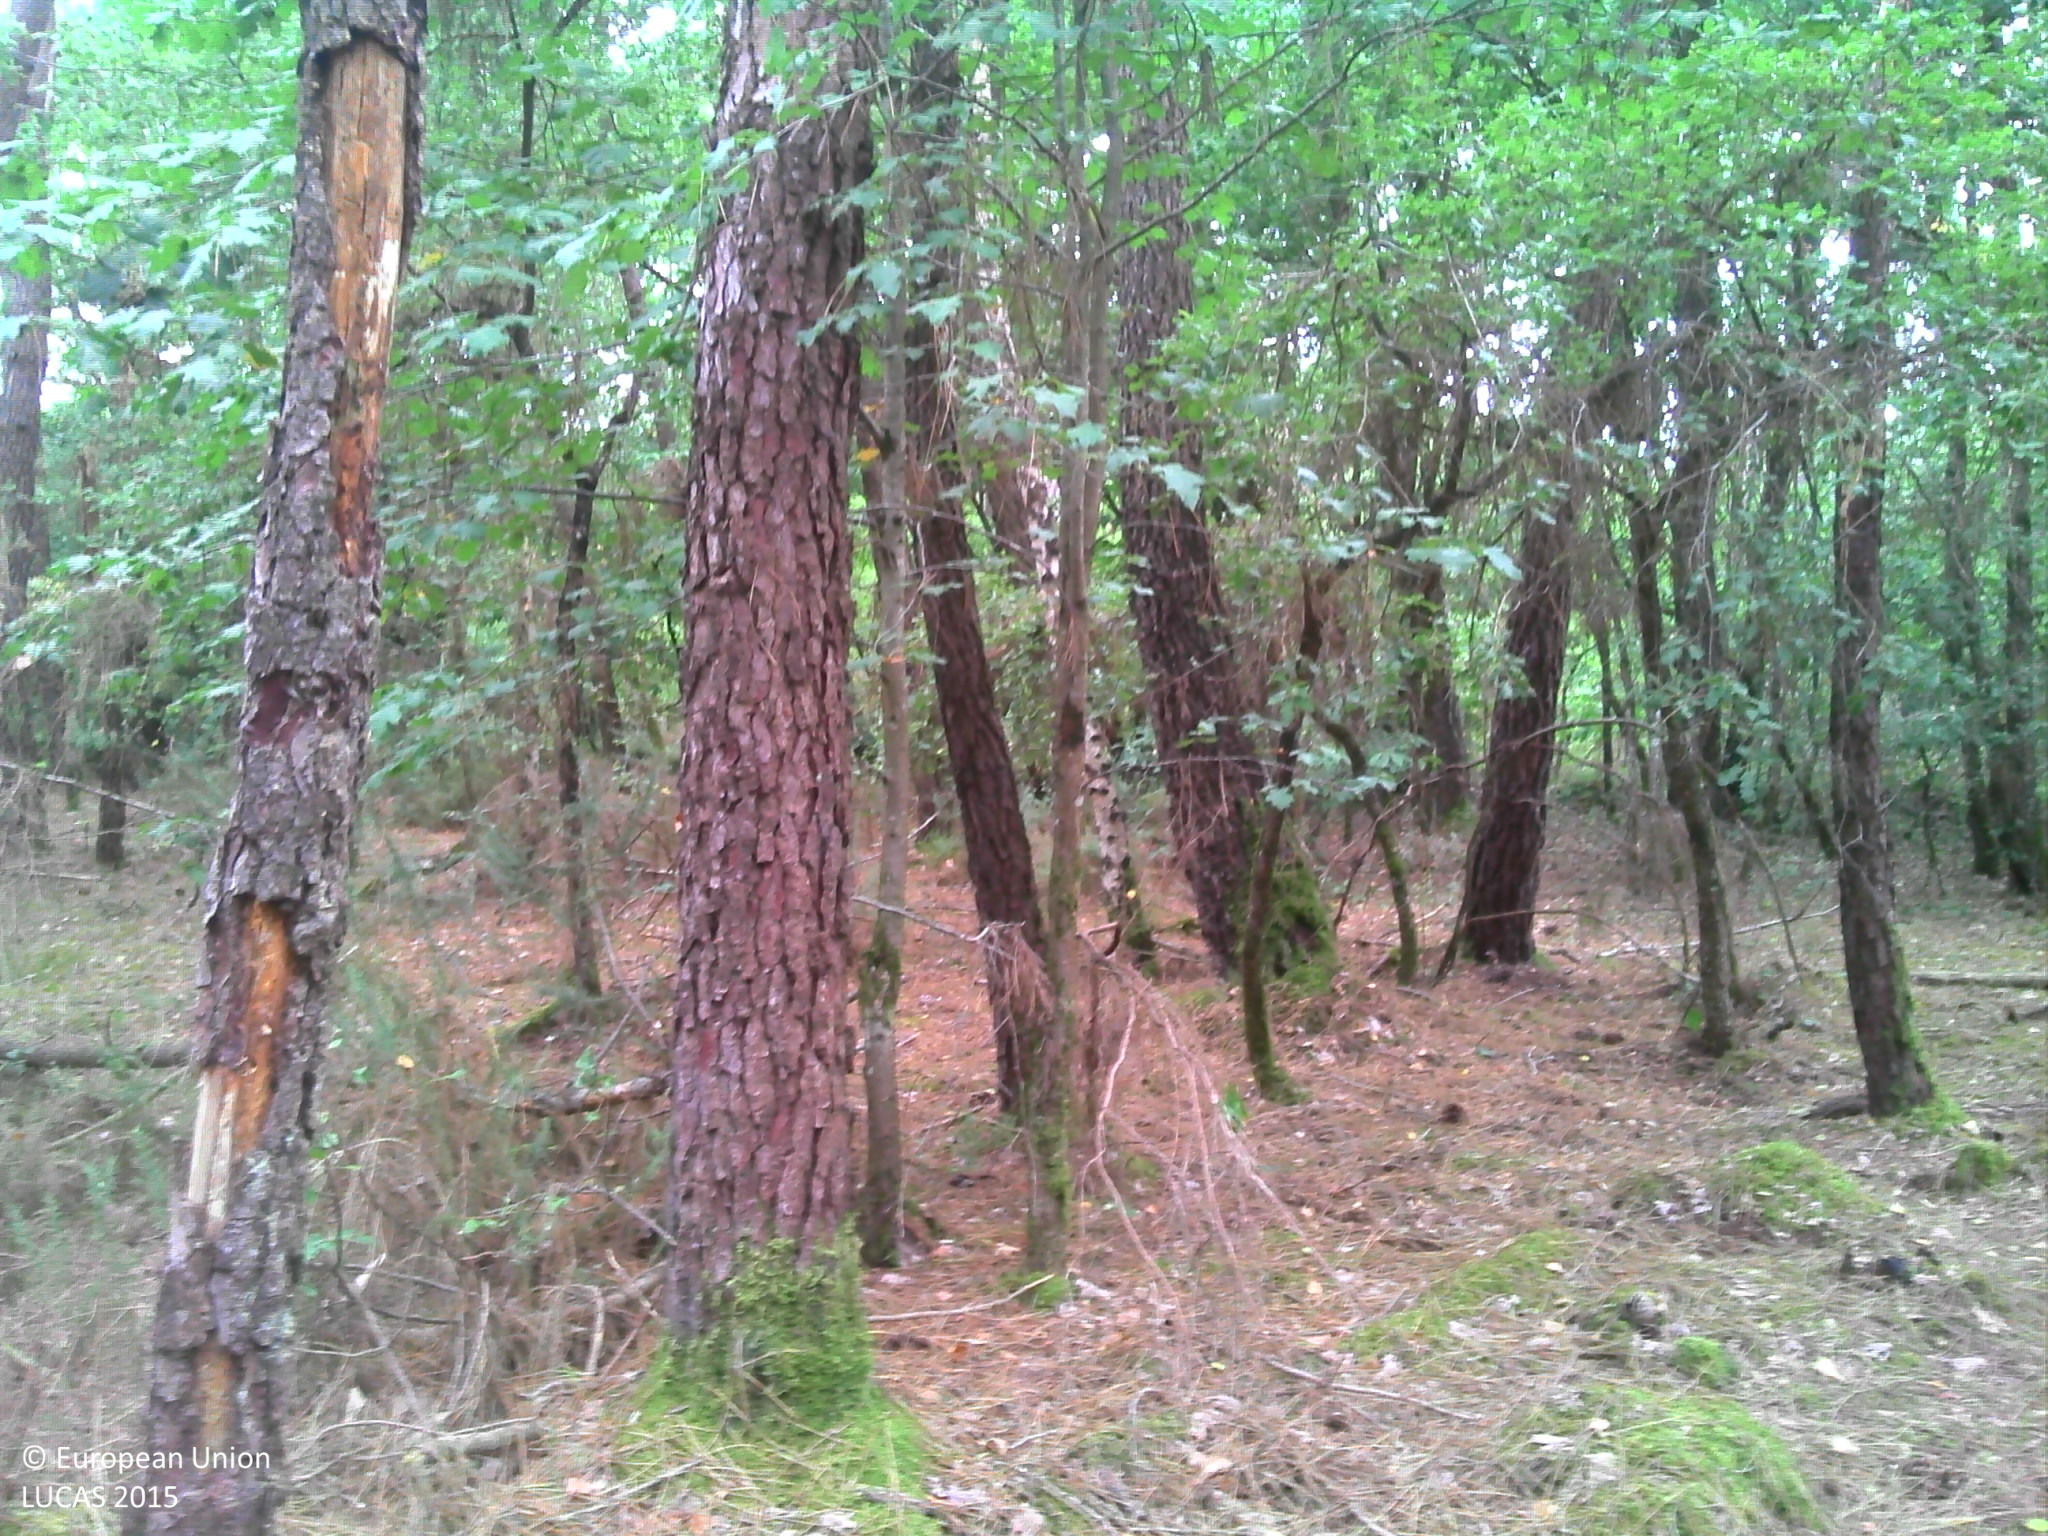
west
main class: Woodland
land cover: Pine dominated mixed woodland
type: hemiboreal forest and nemoral coniferous forest and mixed broadleaved-coniferous forest
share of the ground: > 75 %
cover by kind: coniferous forest trees 50 %, broadleaved forest trees 20 %, shrubs 15 %, herbaceous plants 10 %, lichens and mosses 5 %
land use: Forestry
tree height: > 5 m
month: July
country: FR
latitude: 46.9900
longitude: 0.4208
